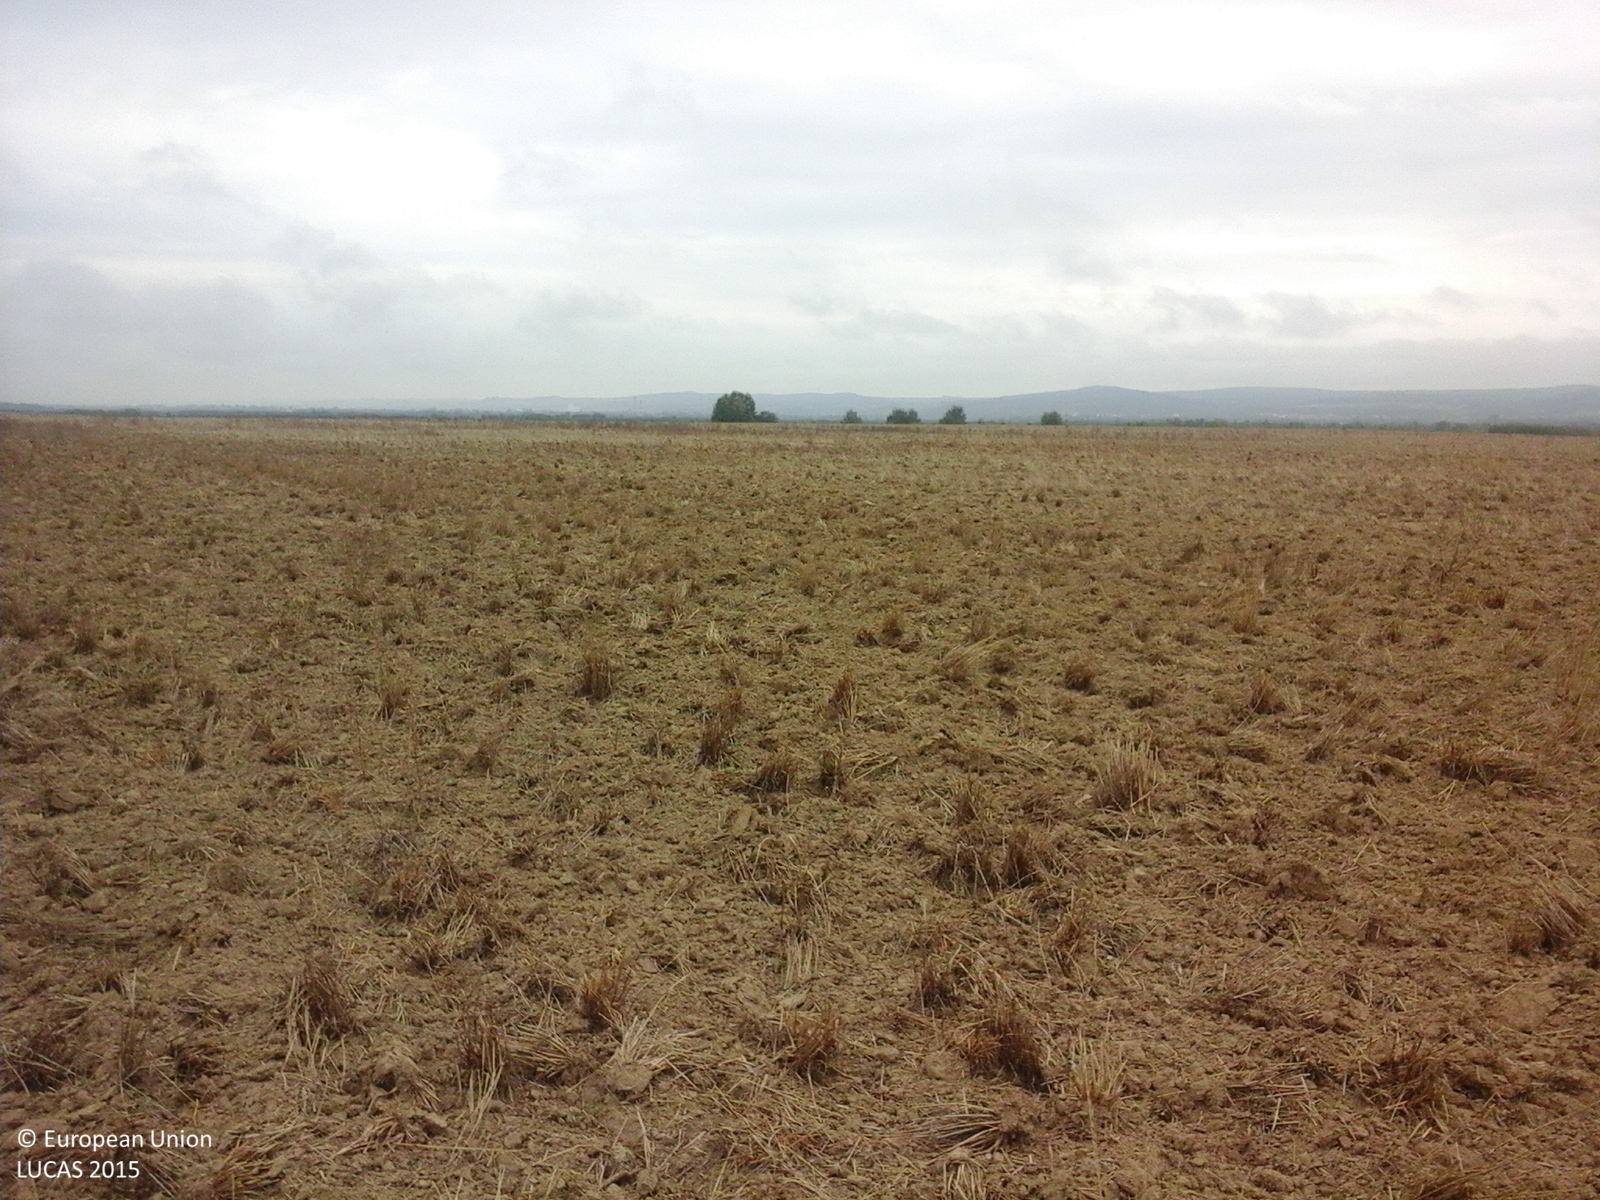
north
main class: Cropland
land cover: Common wheat
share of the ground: < 10 %
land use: Agriculture (excluding fallow land and kitchen gardens)
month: September
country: RO
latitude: 45.6207
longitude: 21.9791
